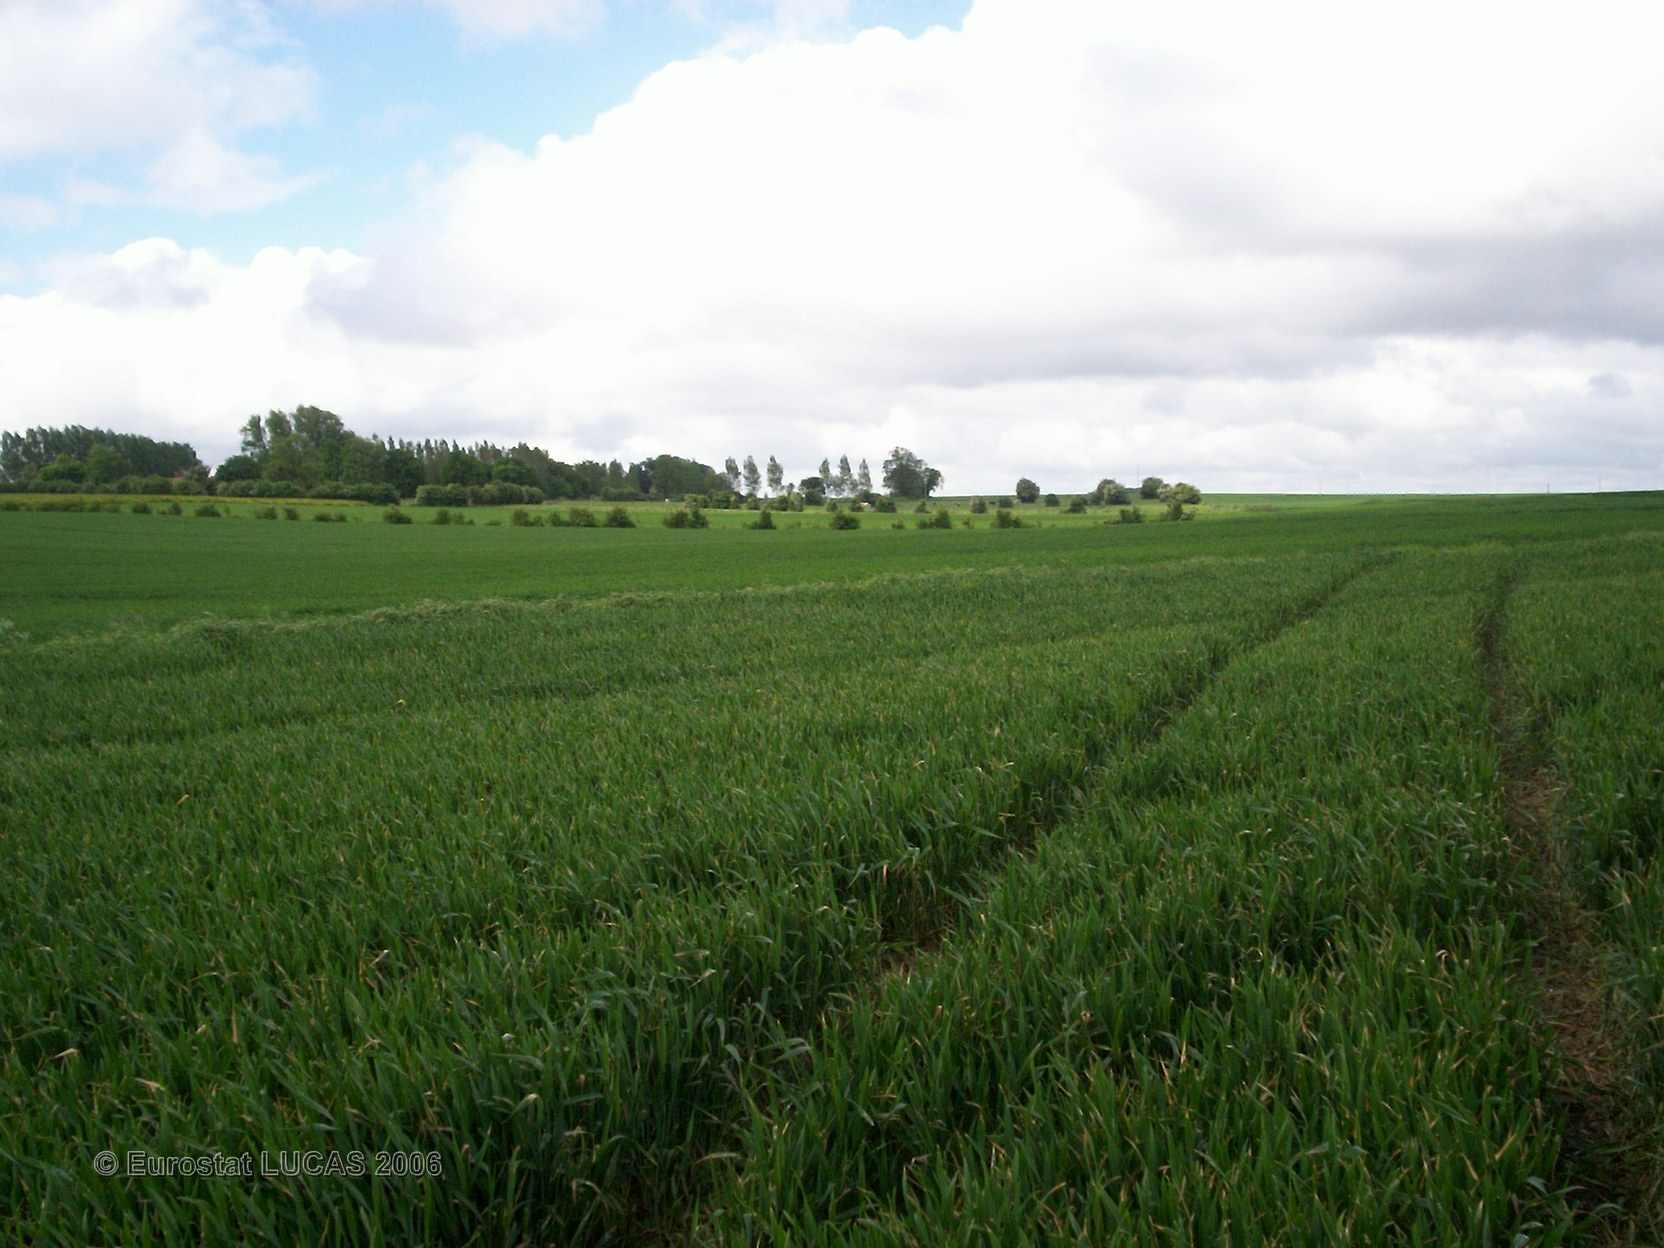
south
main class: Cropland
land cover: Common wheat
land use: Agriculture (excluding fallow land and kitchen gardens)
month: May
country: FR
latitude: 50.1110
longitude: 2.6752
